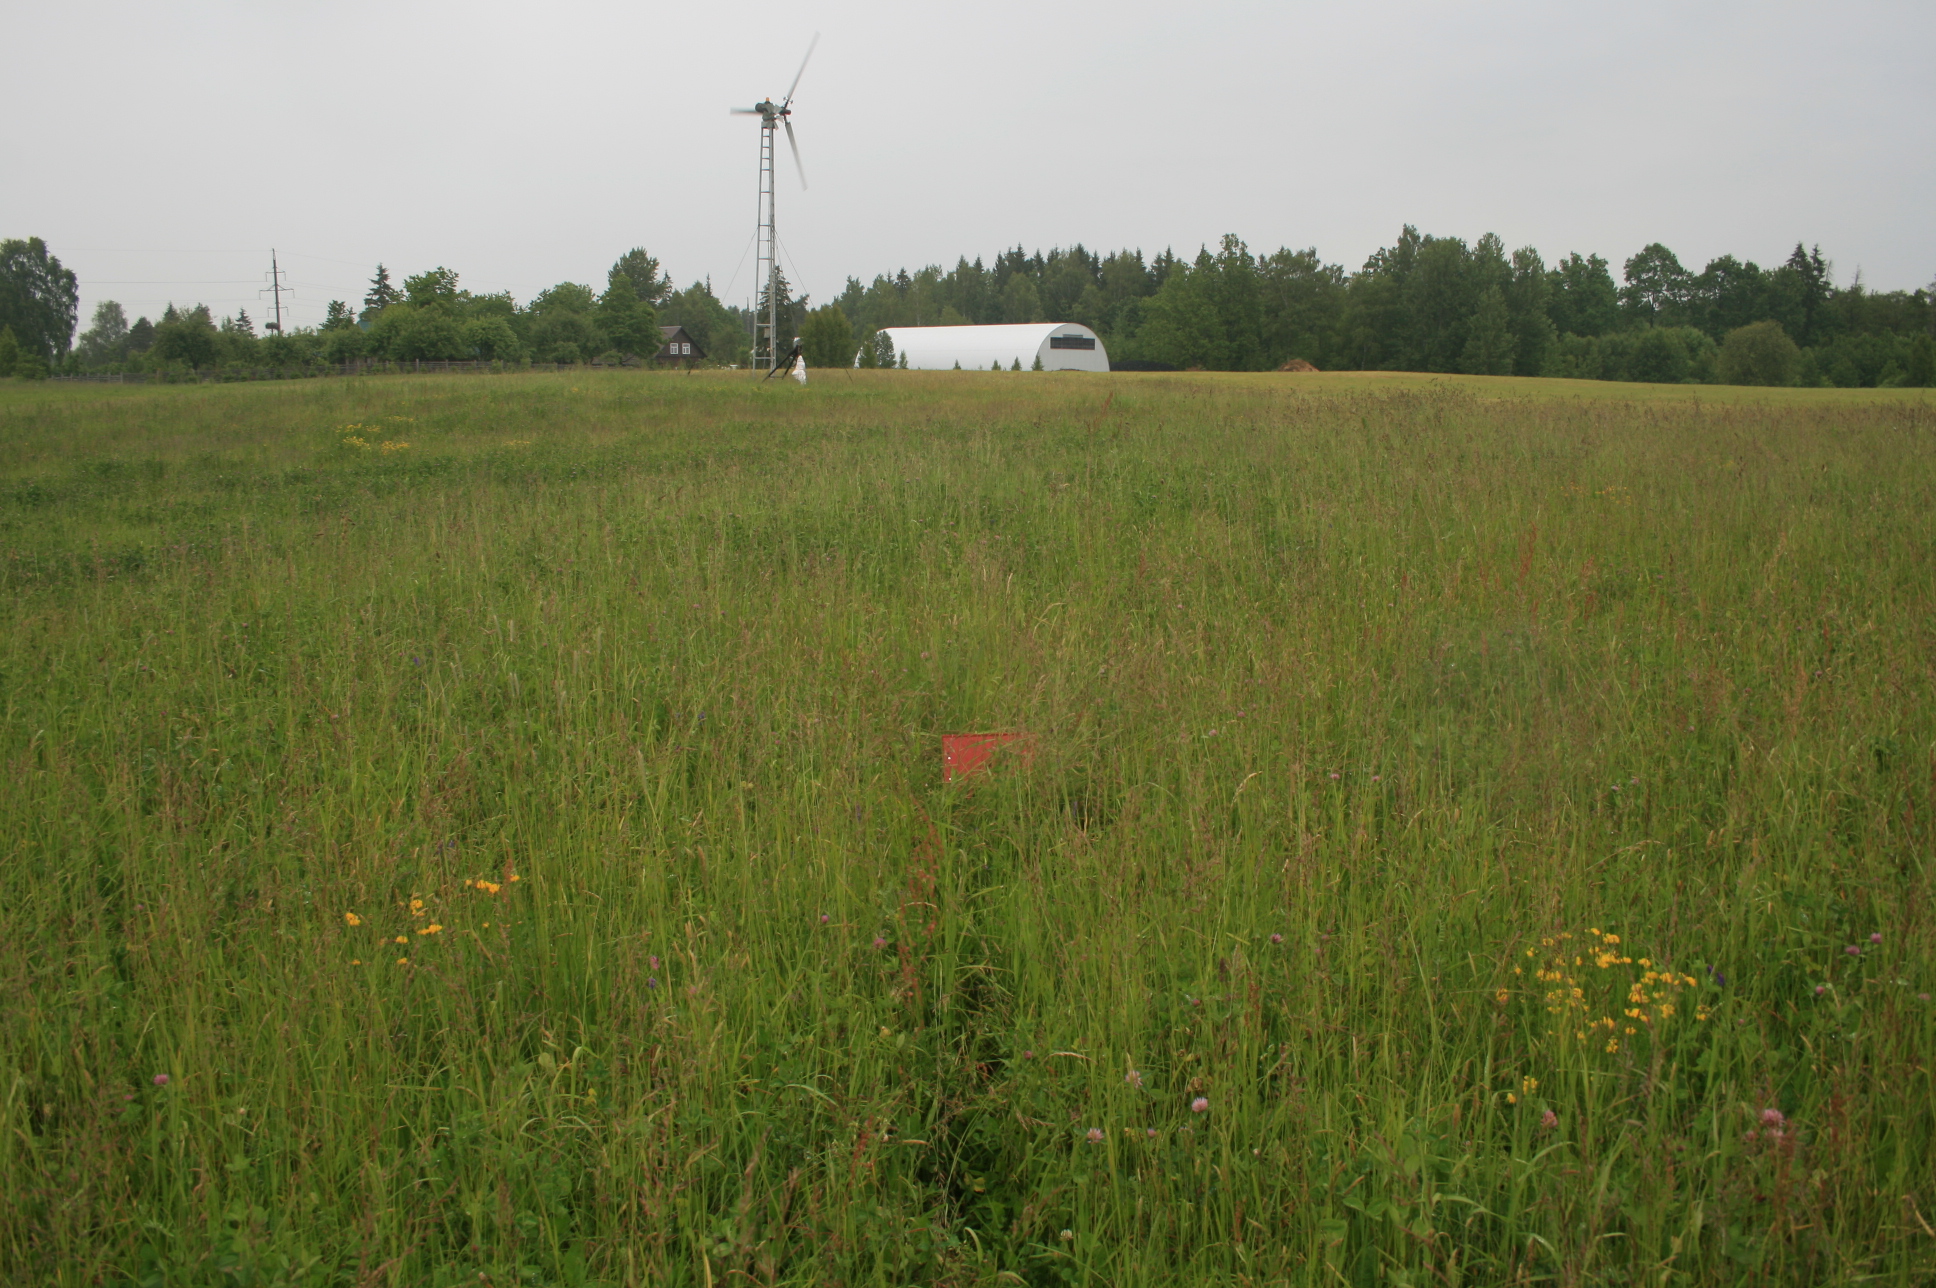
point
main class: Grassland
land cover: Grassland without tree/shrub cover
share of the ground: > 75 %
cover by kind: herbaceous plants 100 %
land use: Agriculture (excluding fallow land and kitchen gardens)
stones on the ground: < 10 %
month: June
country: LT
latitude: 55.4911
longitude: 22.2277
